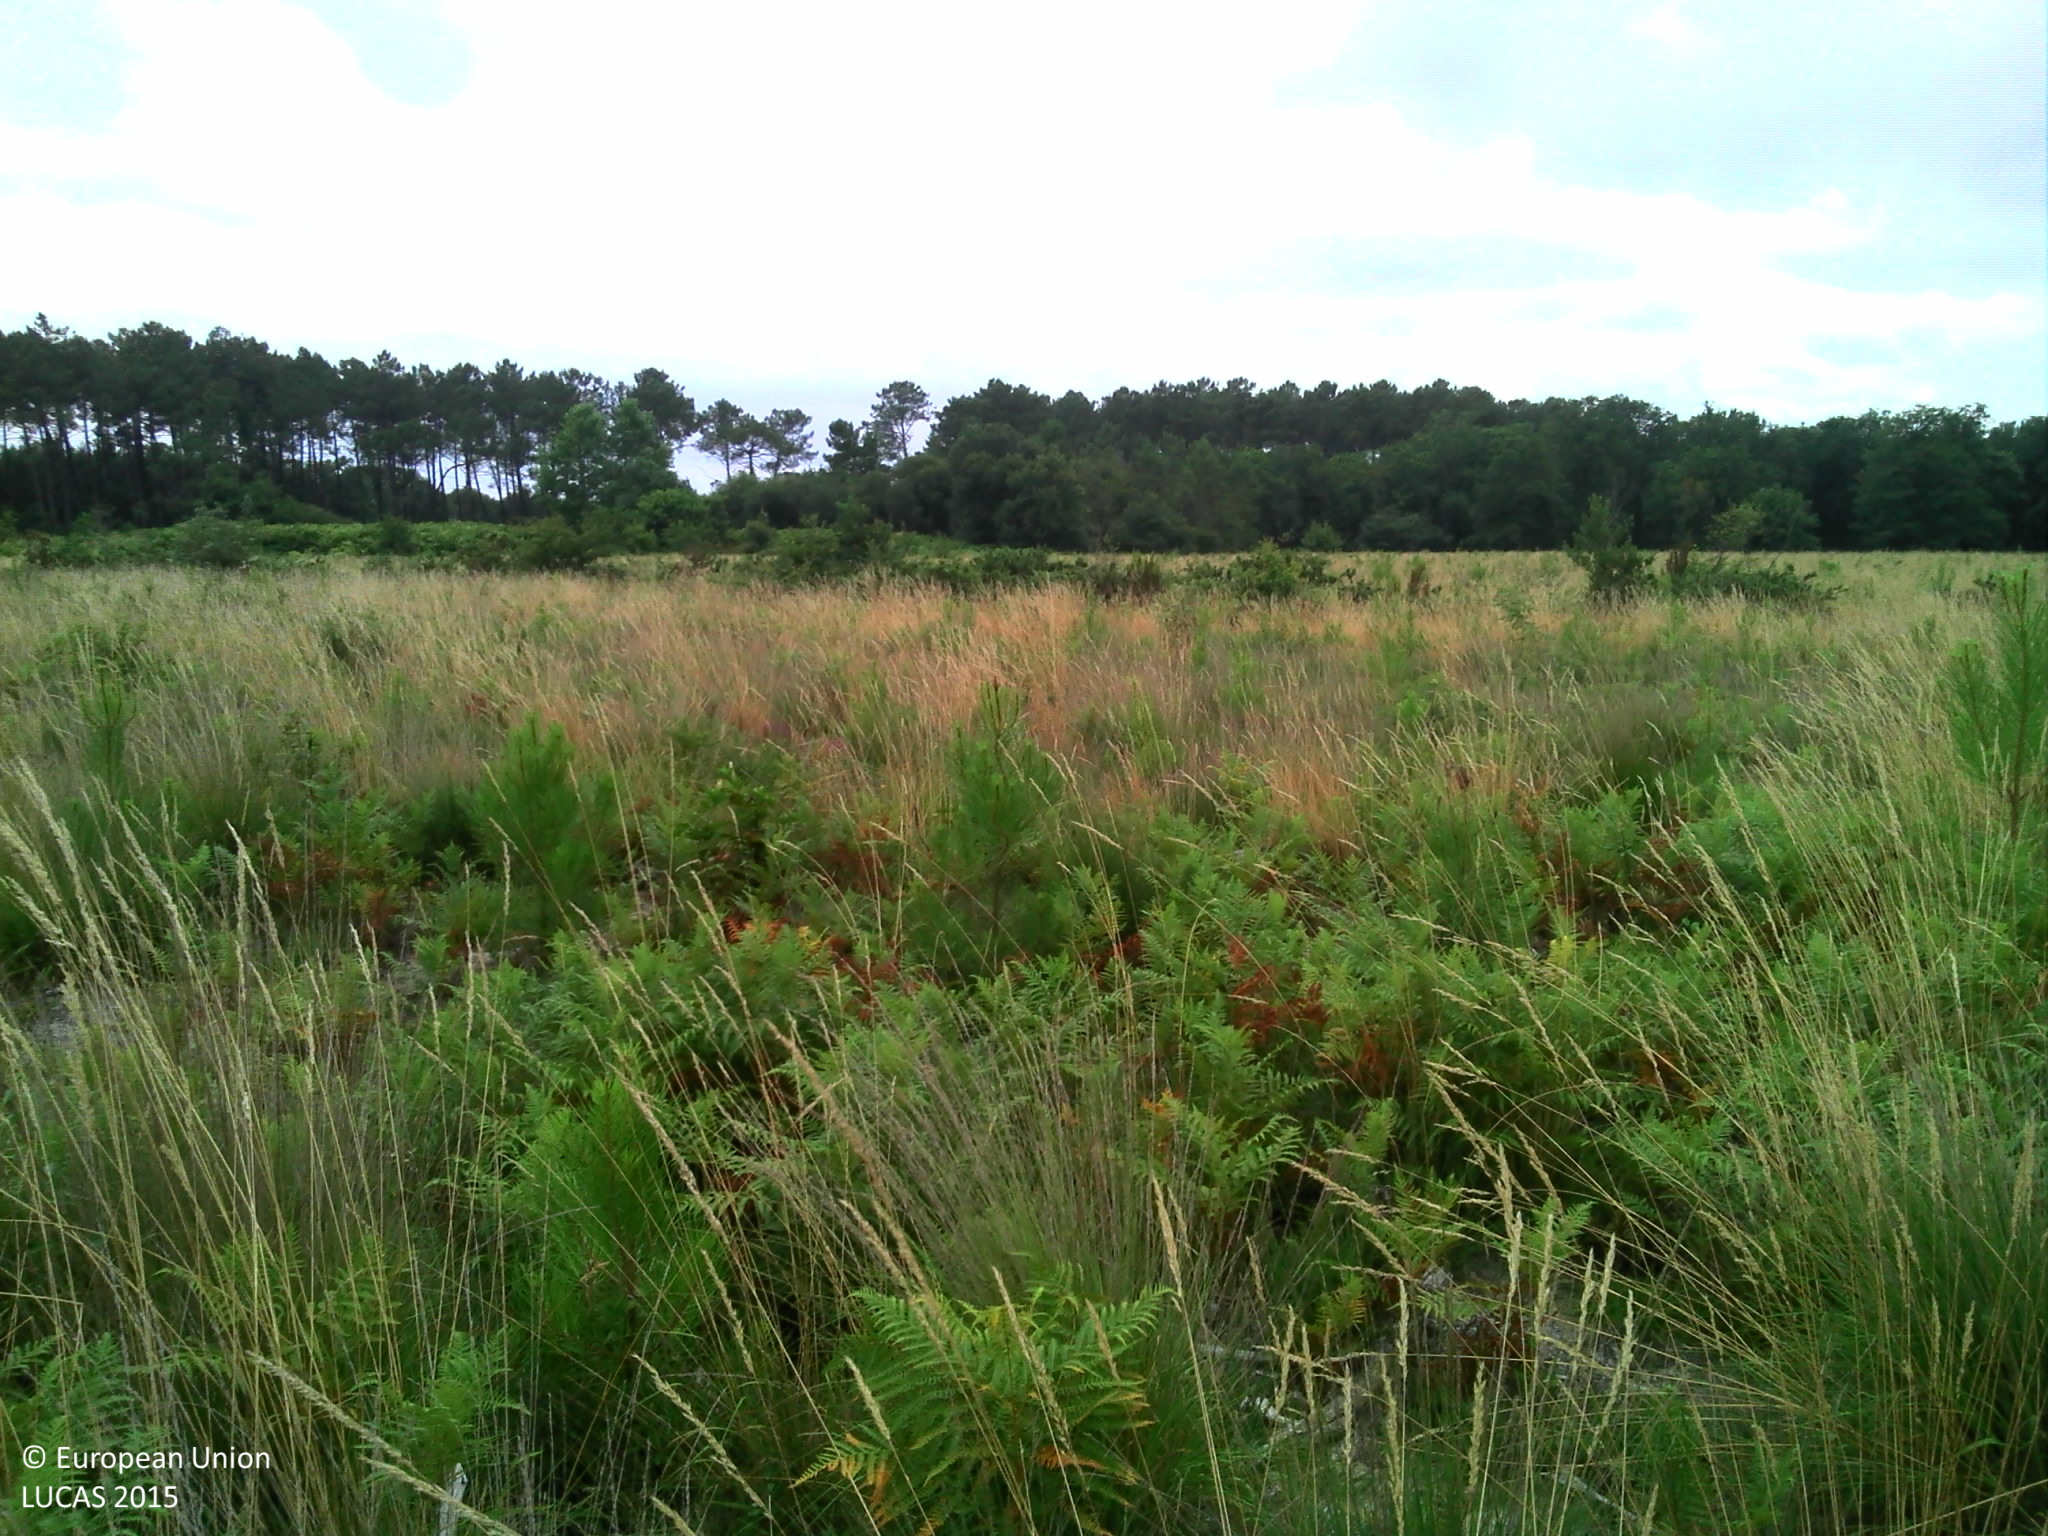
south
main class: Shrubland
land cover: Shrubland with sparse tree cover
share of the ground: > 75 %
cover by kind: shrubs 60 %, herbaceous plants 20 %, lichens and mosses 15 %, coniferous forest trees 5 %
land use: Forestry
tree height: > 5 m
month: July
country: FR
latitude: 43.6774
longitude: -1.2929
